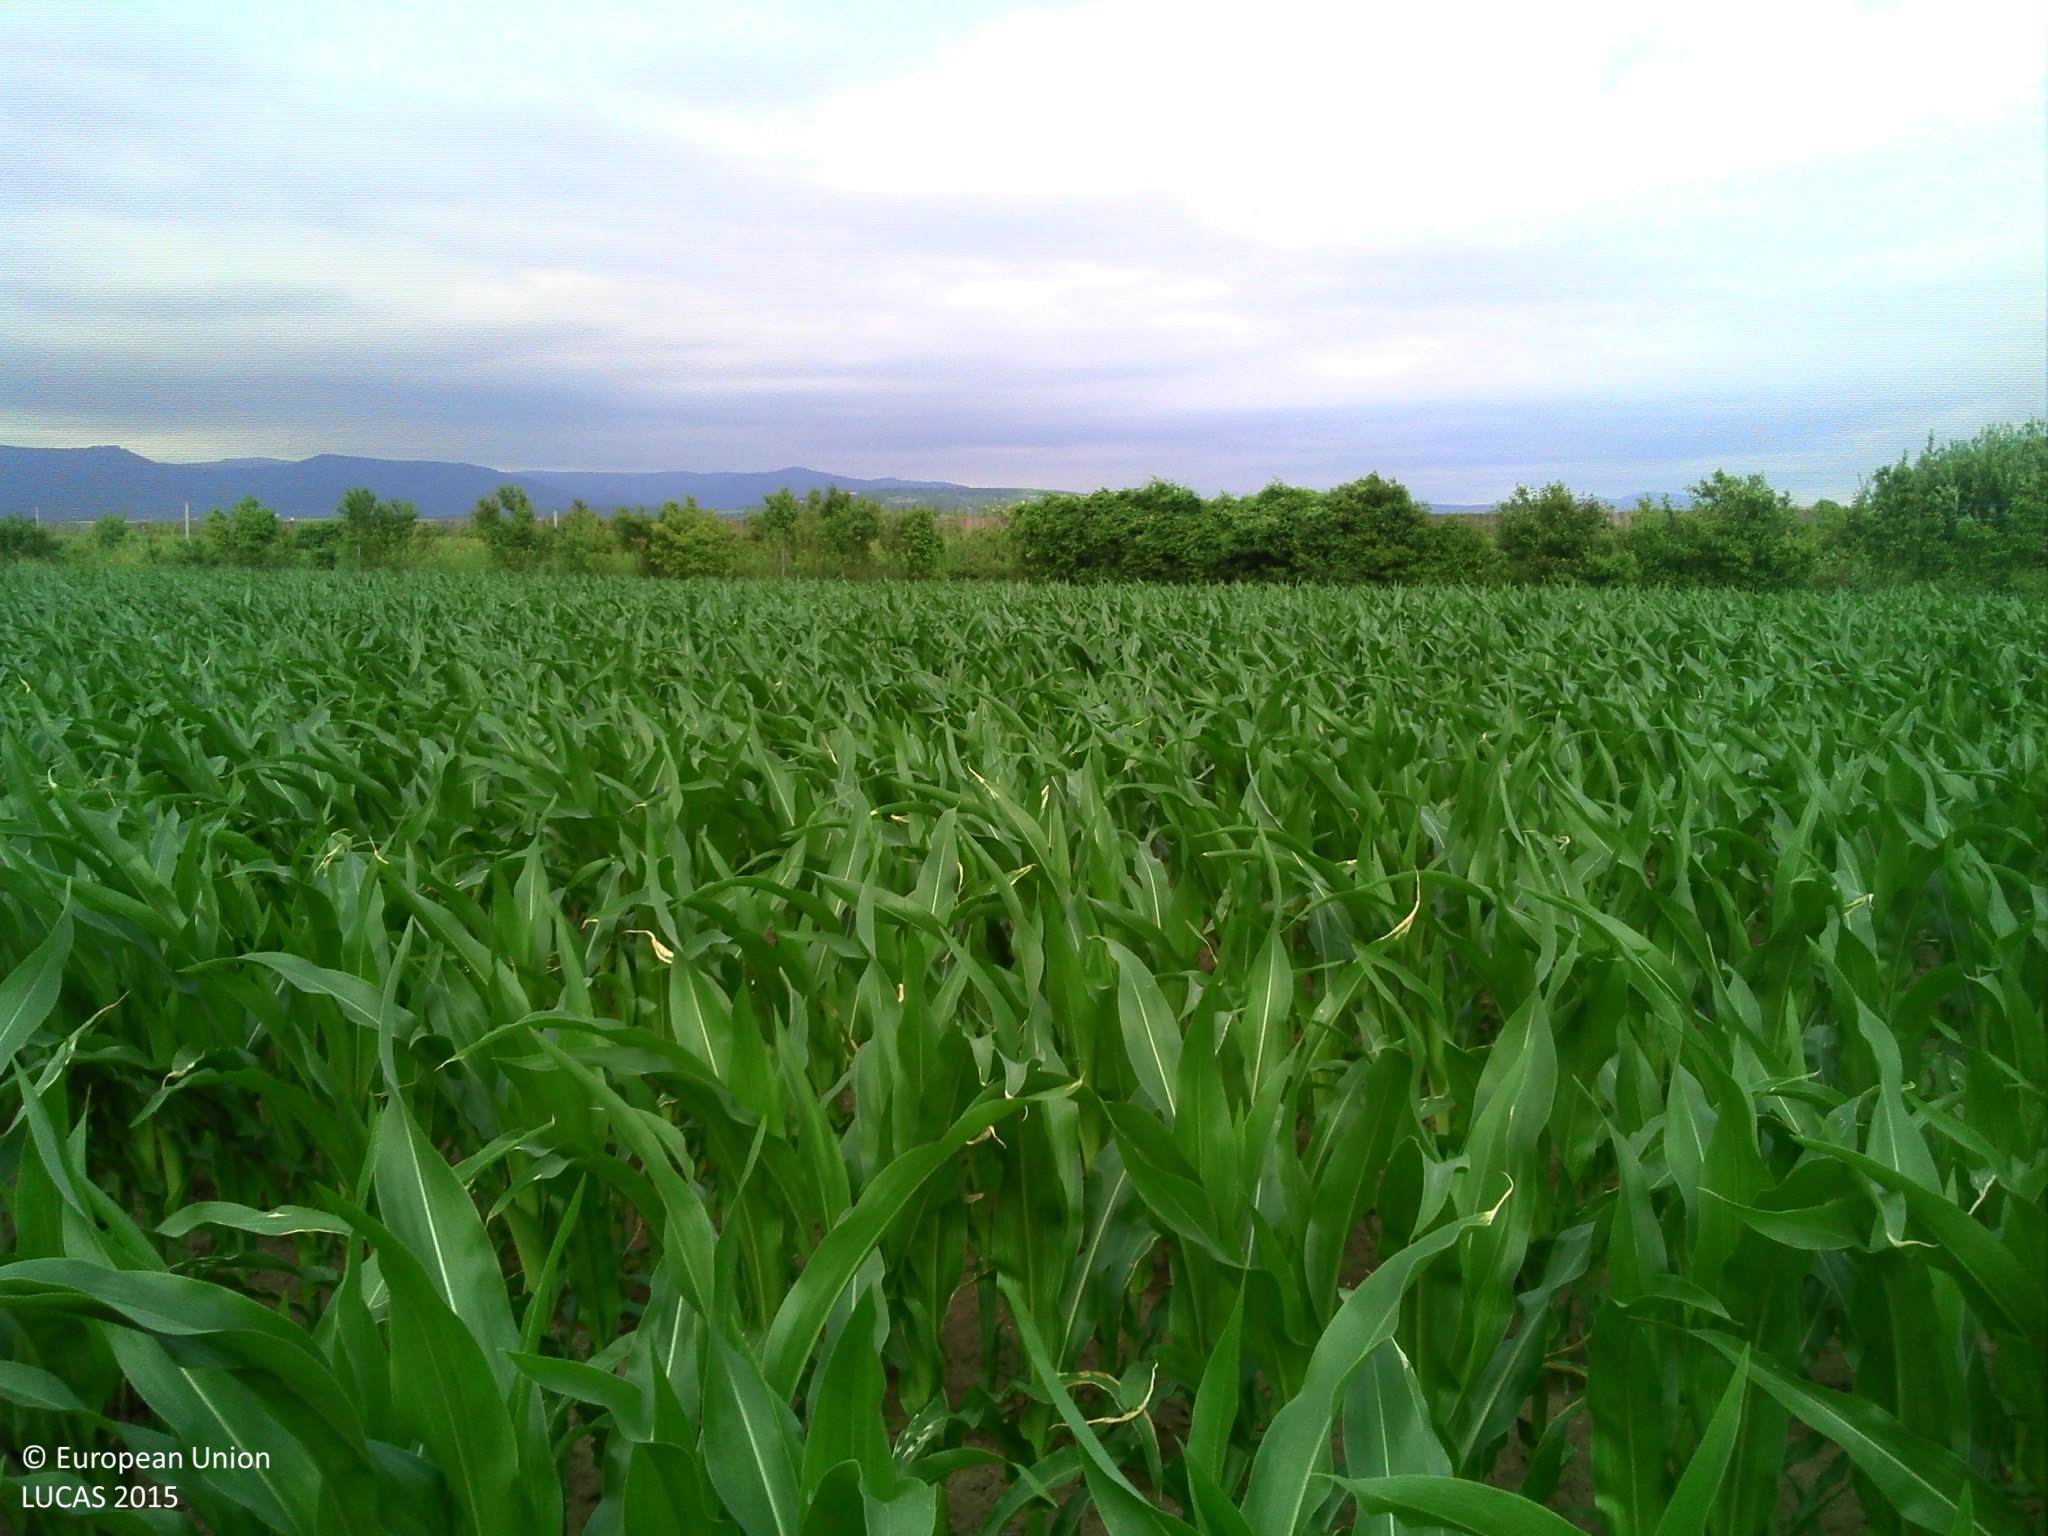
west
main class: Cropland
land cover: Maize
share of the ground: 25 - 50 %
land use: Agriculture (excluding fallow land and kitchen gardens)
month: June
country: FR
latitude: 48.4844
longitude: 7.5520
